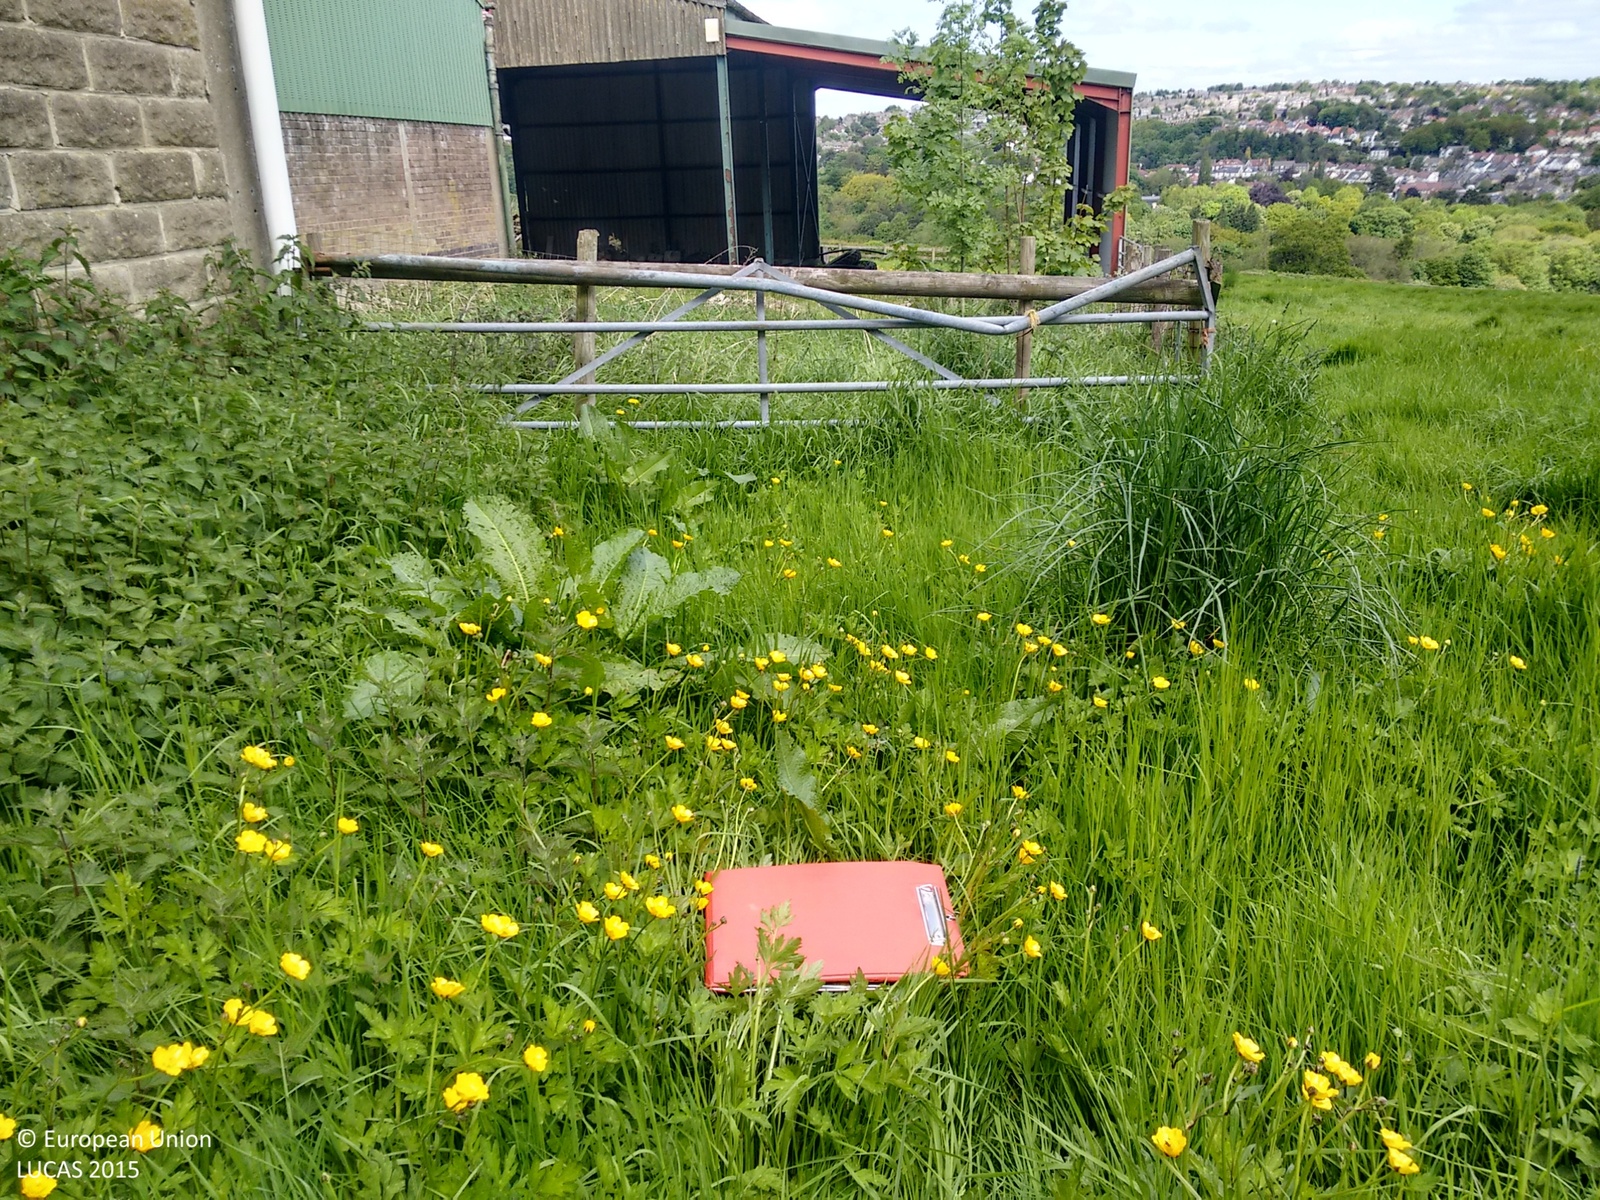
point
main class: Grassland
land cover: Grassland without tree/shrub cover
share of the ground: > 75 %
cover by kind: herbaceous plants 100 %
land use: Agriculture (excluding fallow land and kitchen gardens)
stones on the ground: < 10 %
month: May
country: GB
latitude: 53.3564
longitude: -1.5448
